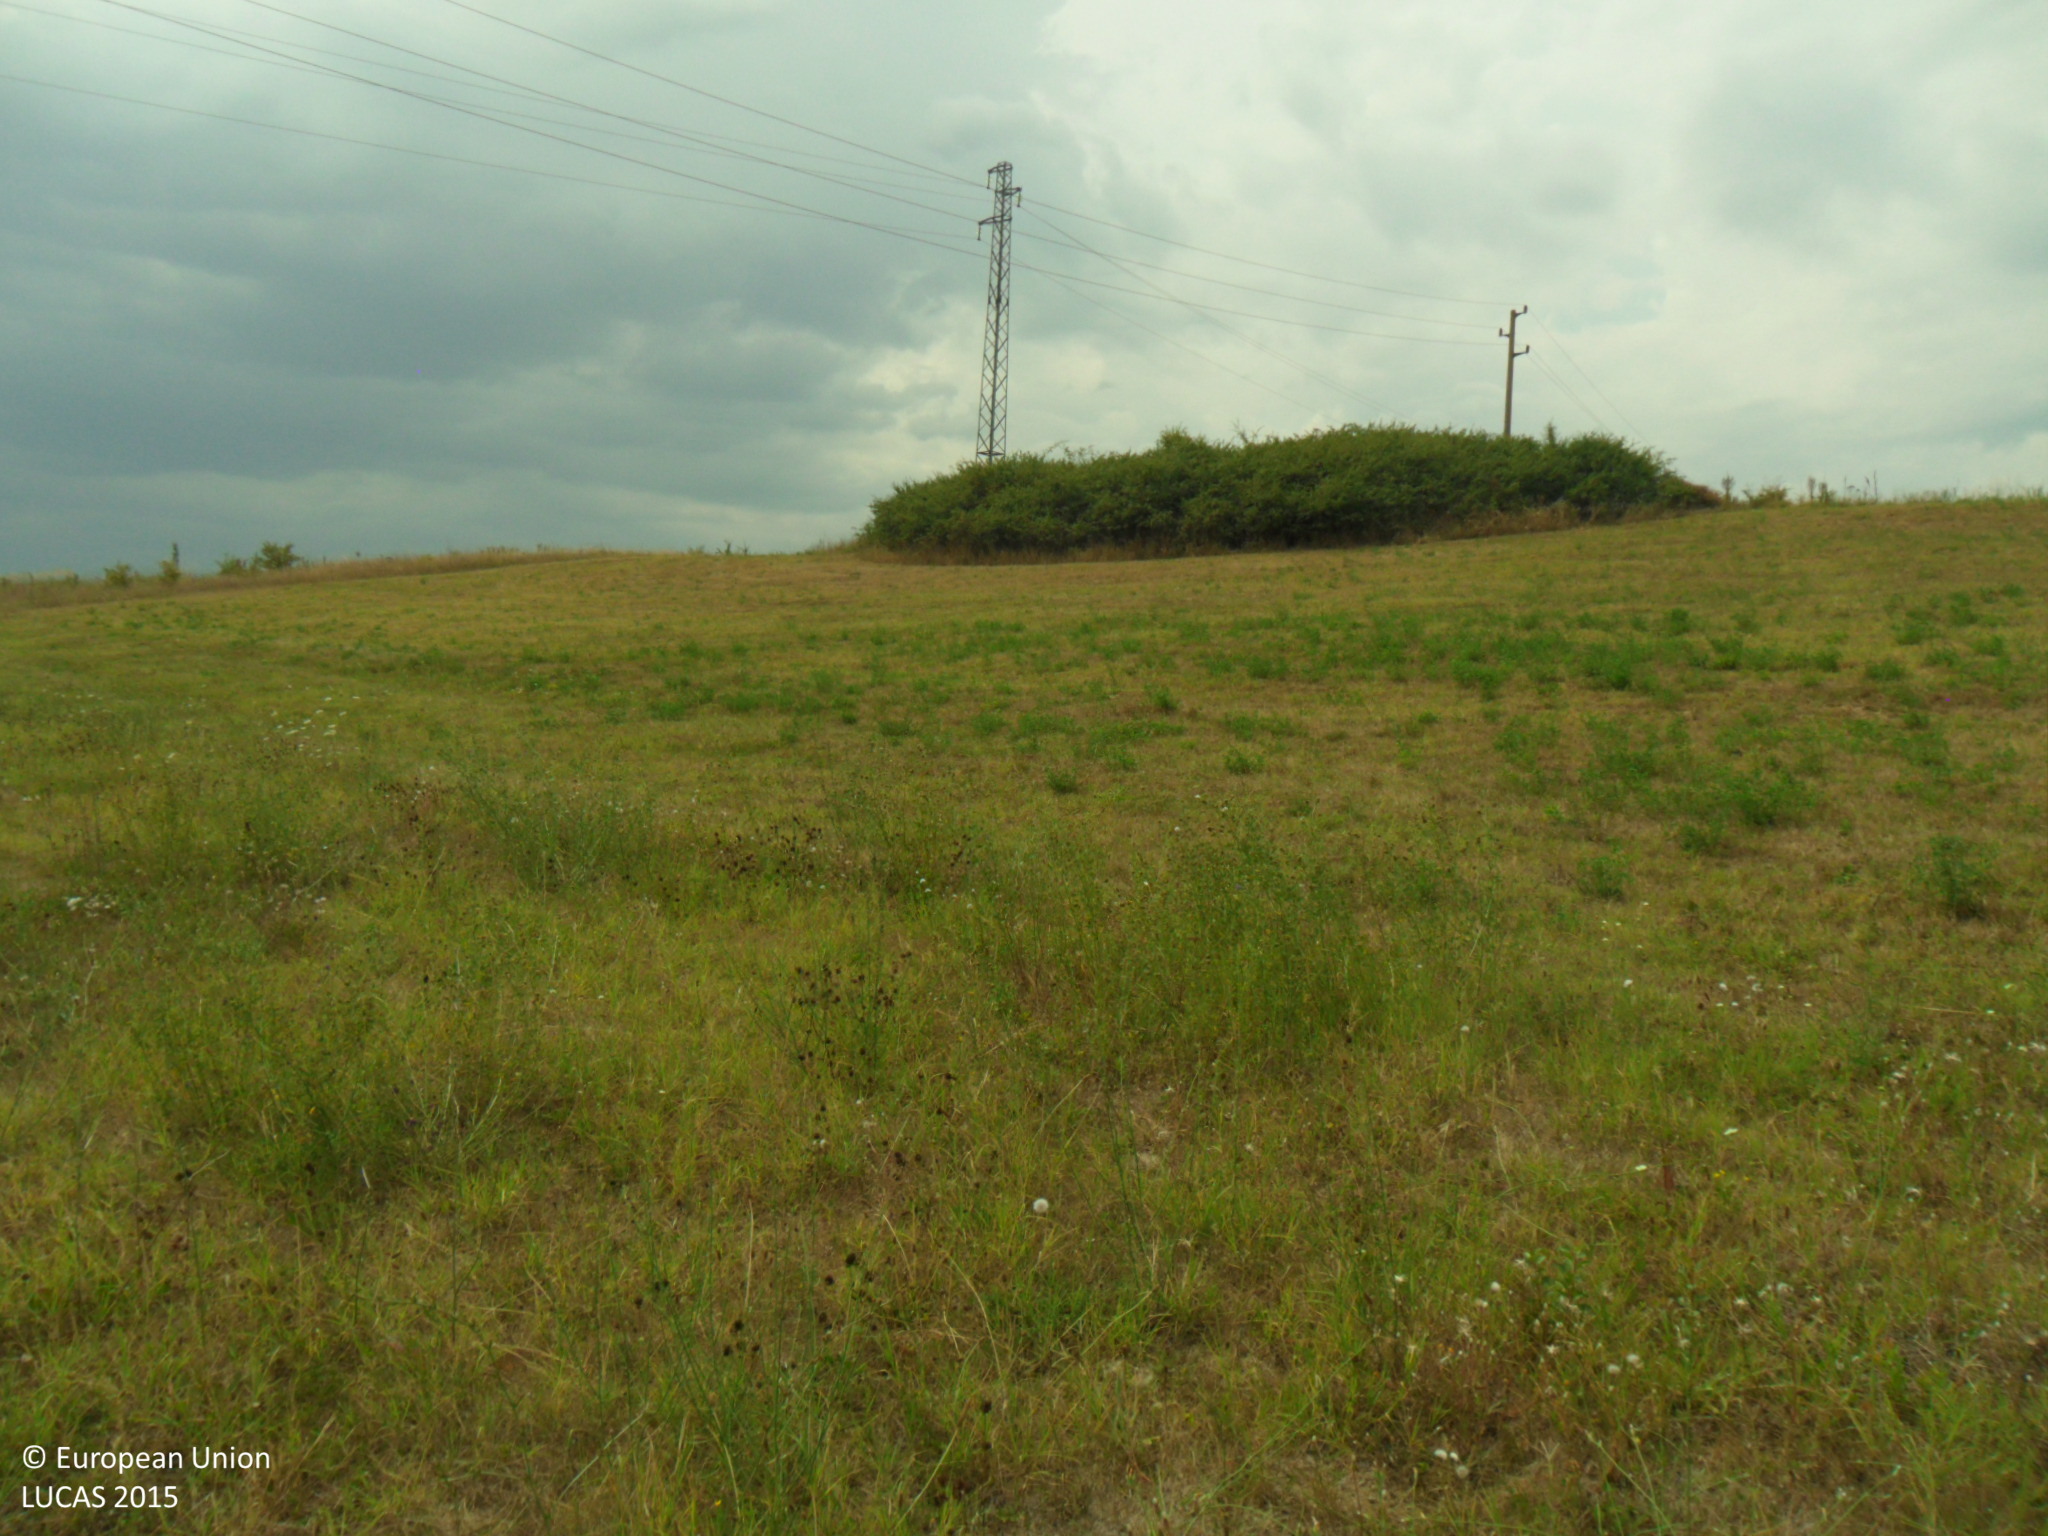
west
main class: Grassland
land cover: Spontaneously vegetated surfaces
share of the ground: > 75 %
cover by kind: herbaceous plants 100 %
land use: Fallow land
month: August
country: BG
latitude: 43.0117
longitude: 26.6535
